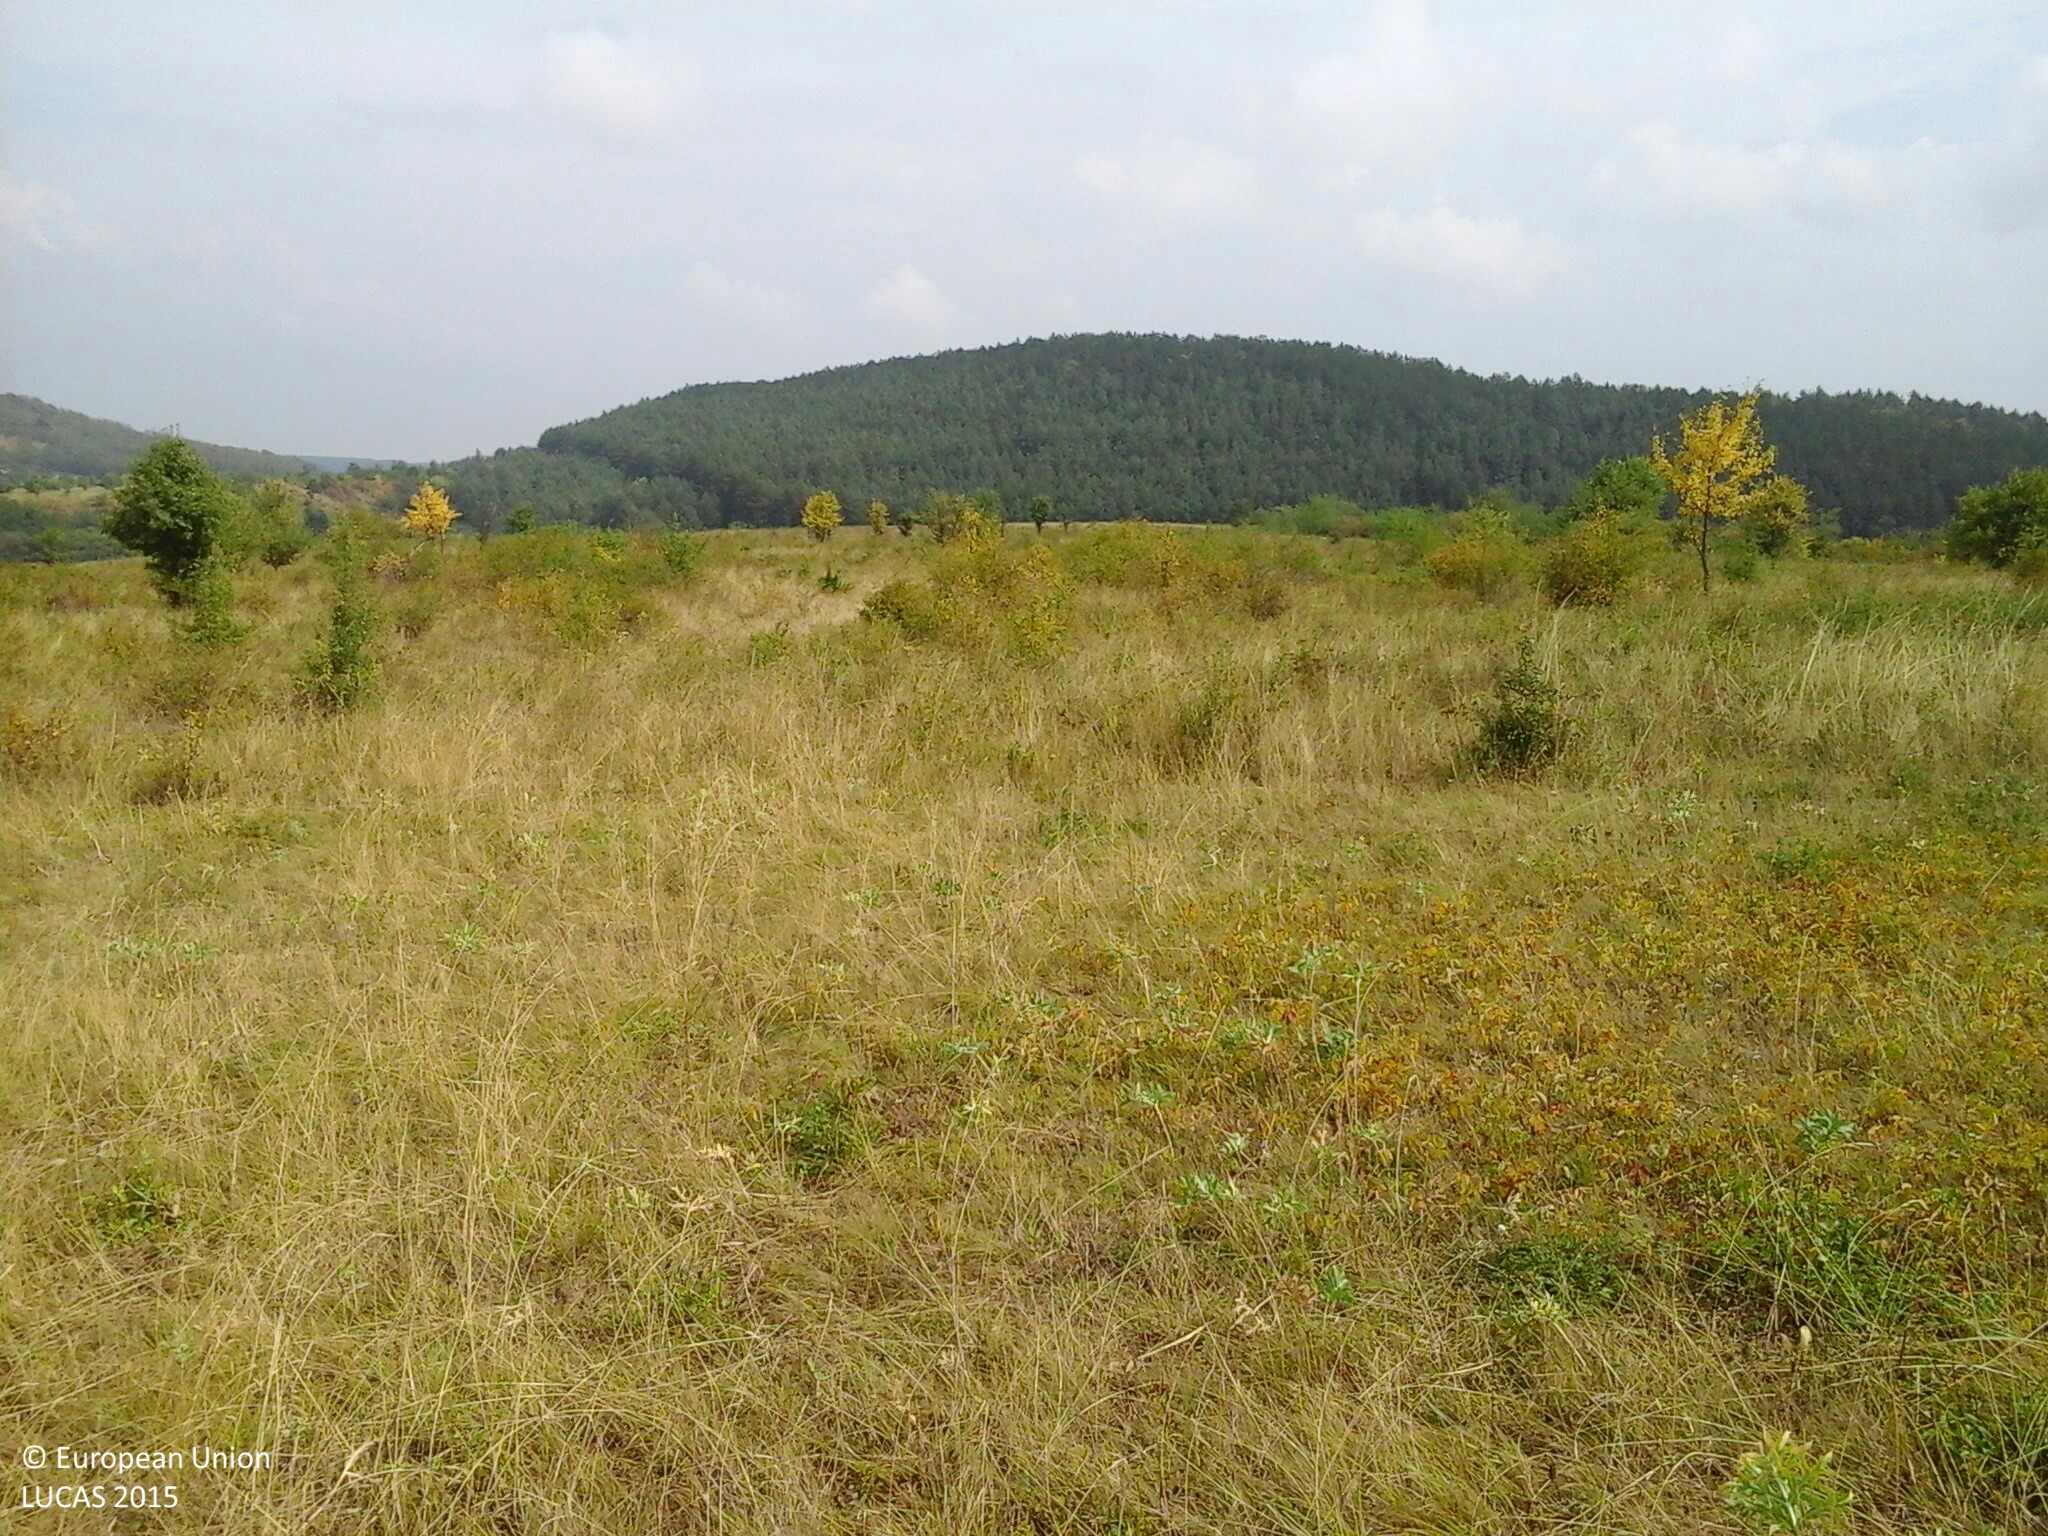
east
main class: Grassland
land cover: Grassland without tree/shrub cover
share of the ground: > 75 %
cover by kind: herbaceous plants 100 %
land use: Agriculture (excluding fallow land and kitchen gardens)
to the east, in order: Grassland without tree/shrub cover; Grassland with sparse tree/shrub cover
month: August
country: HU
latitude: 47.9775
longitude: 20.6584
